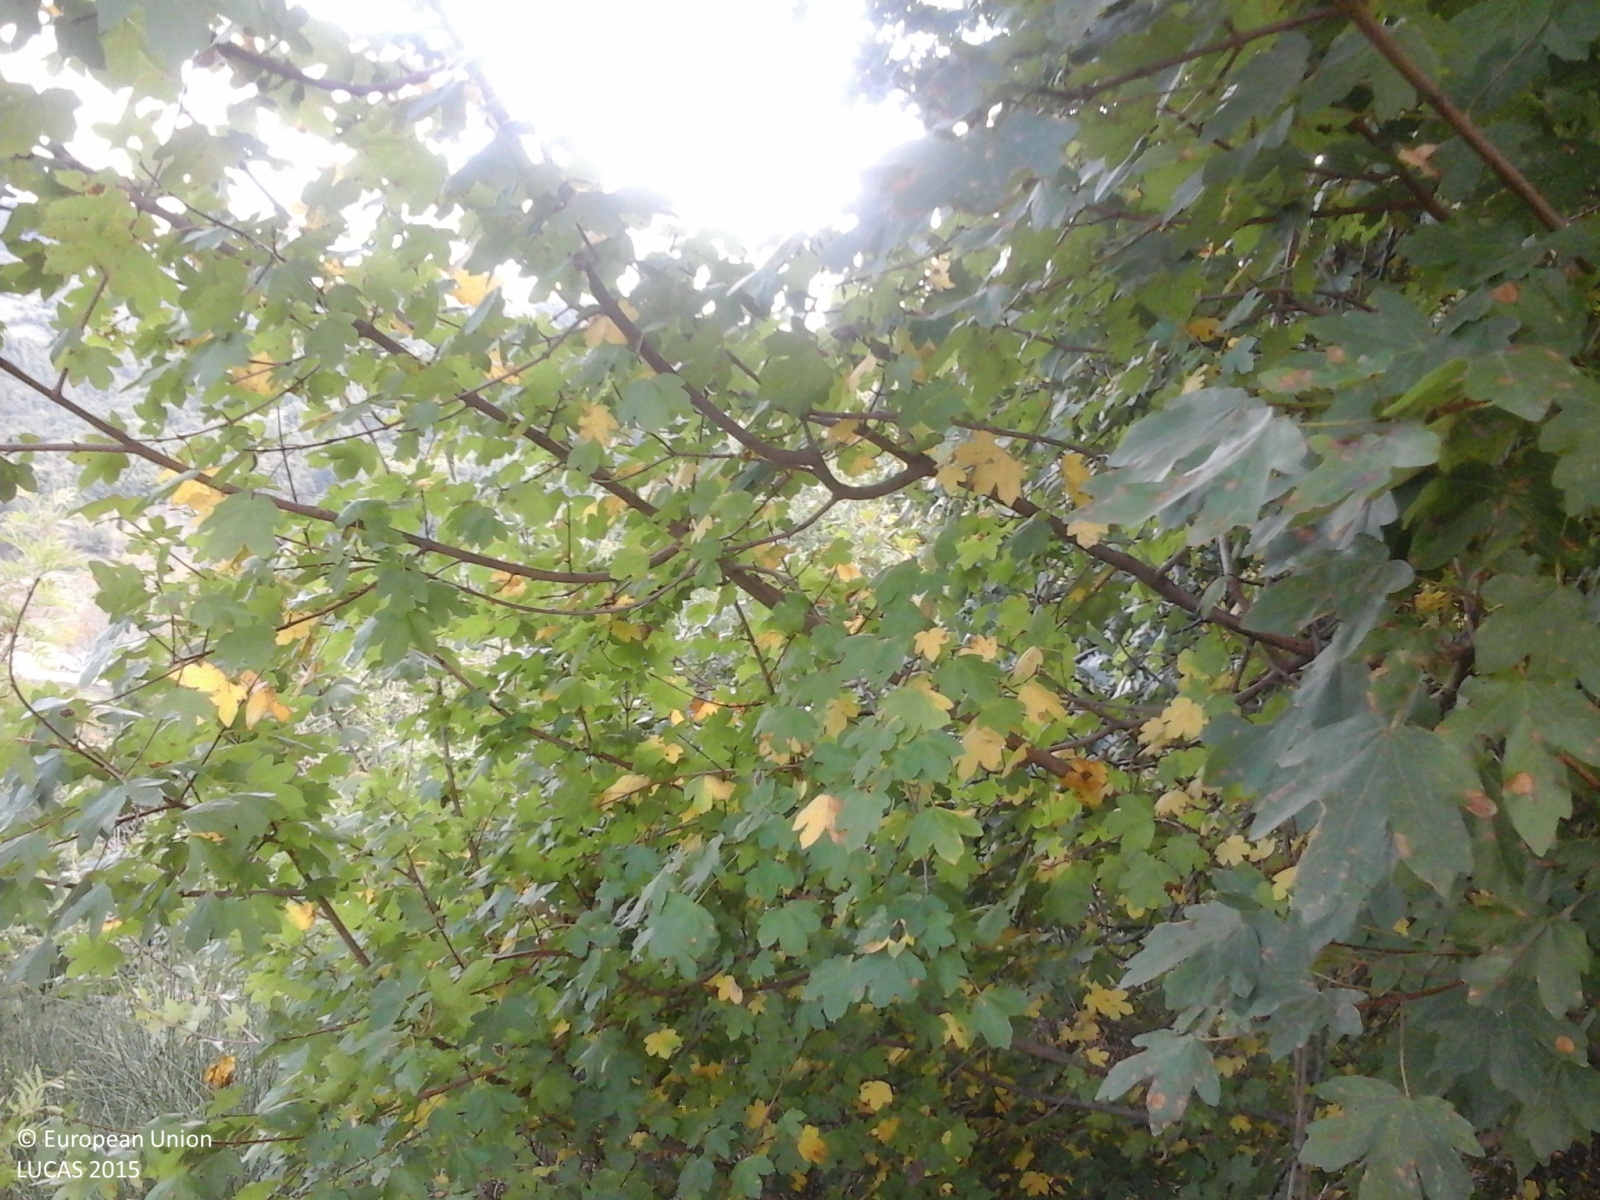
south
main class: Woodland
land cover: Broadleaved woodland
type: thermophilous deciduous forest
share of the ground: > 75 %
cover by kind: broadleaved forest trees 85 %, herbaceous plants 10 %, shrubs 5 %
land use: Semi-natural and natural areas not in use
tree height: > 5 m
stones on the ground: < 10 %
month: October
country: IT
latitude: 43.1978
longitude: 12.6385
